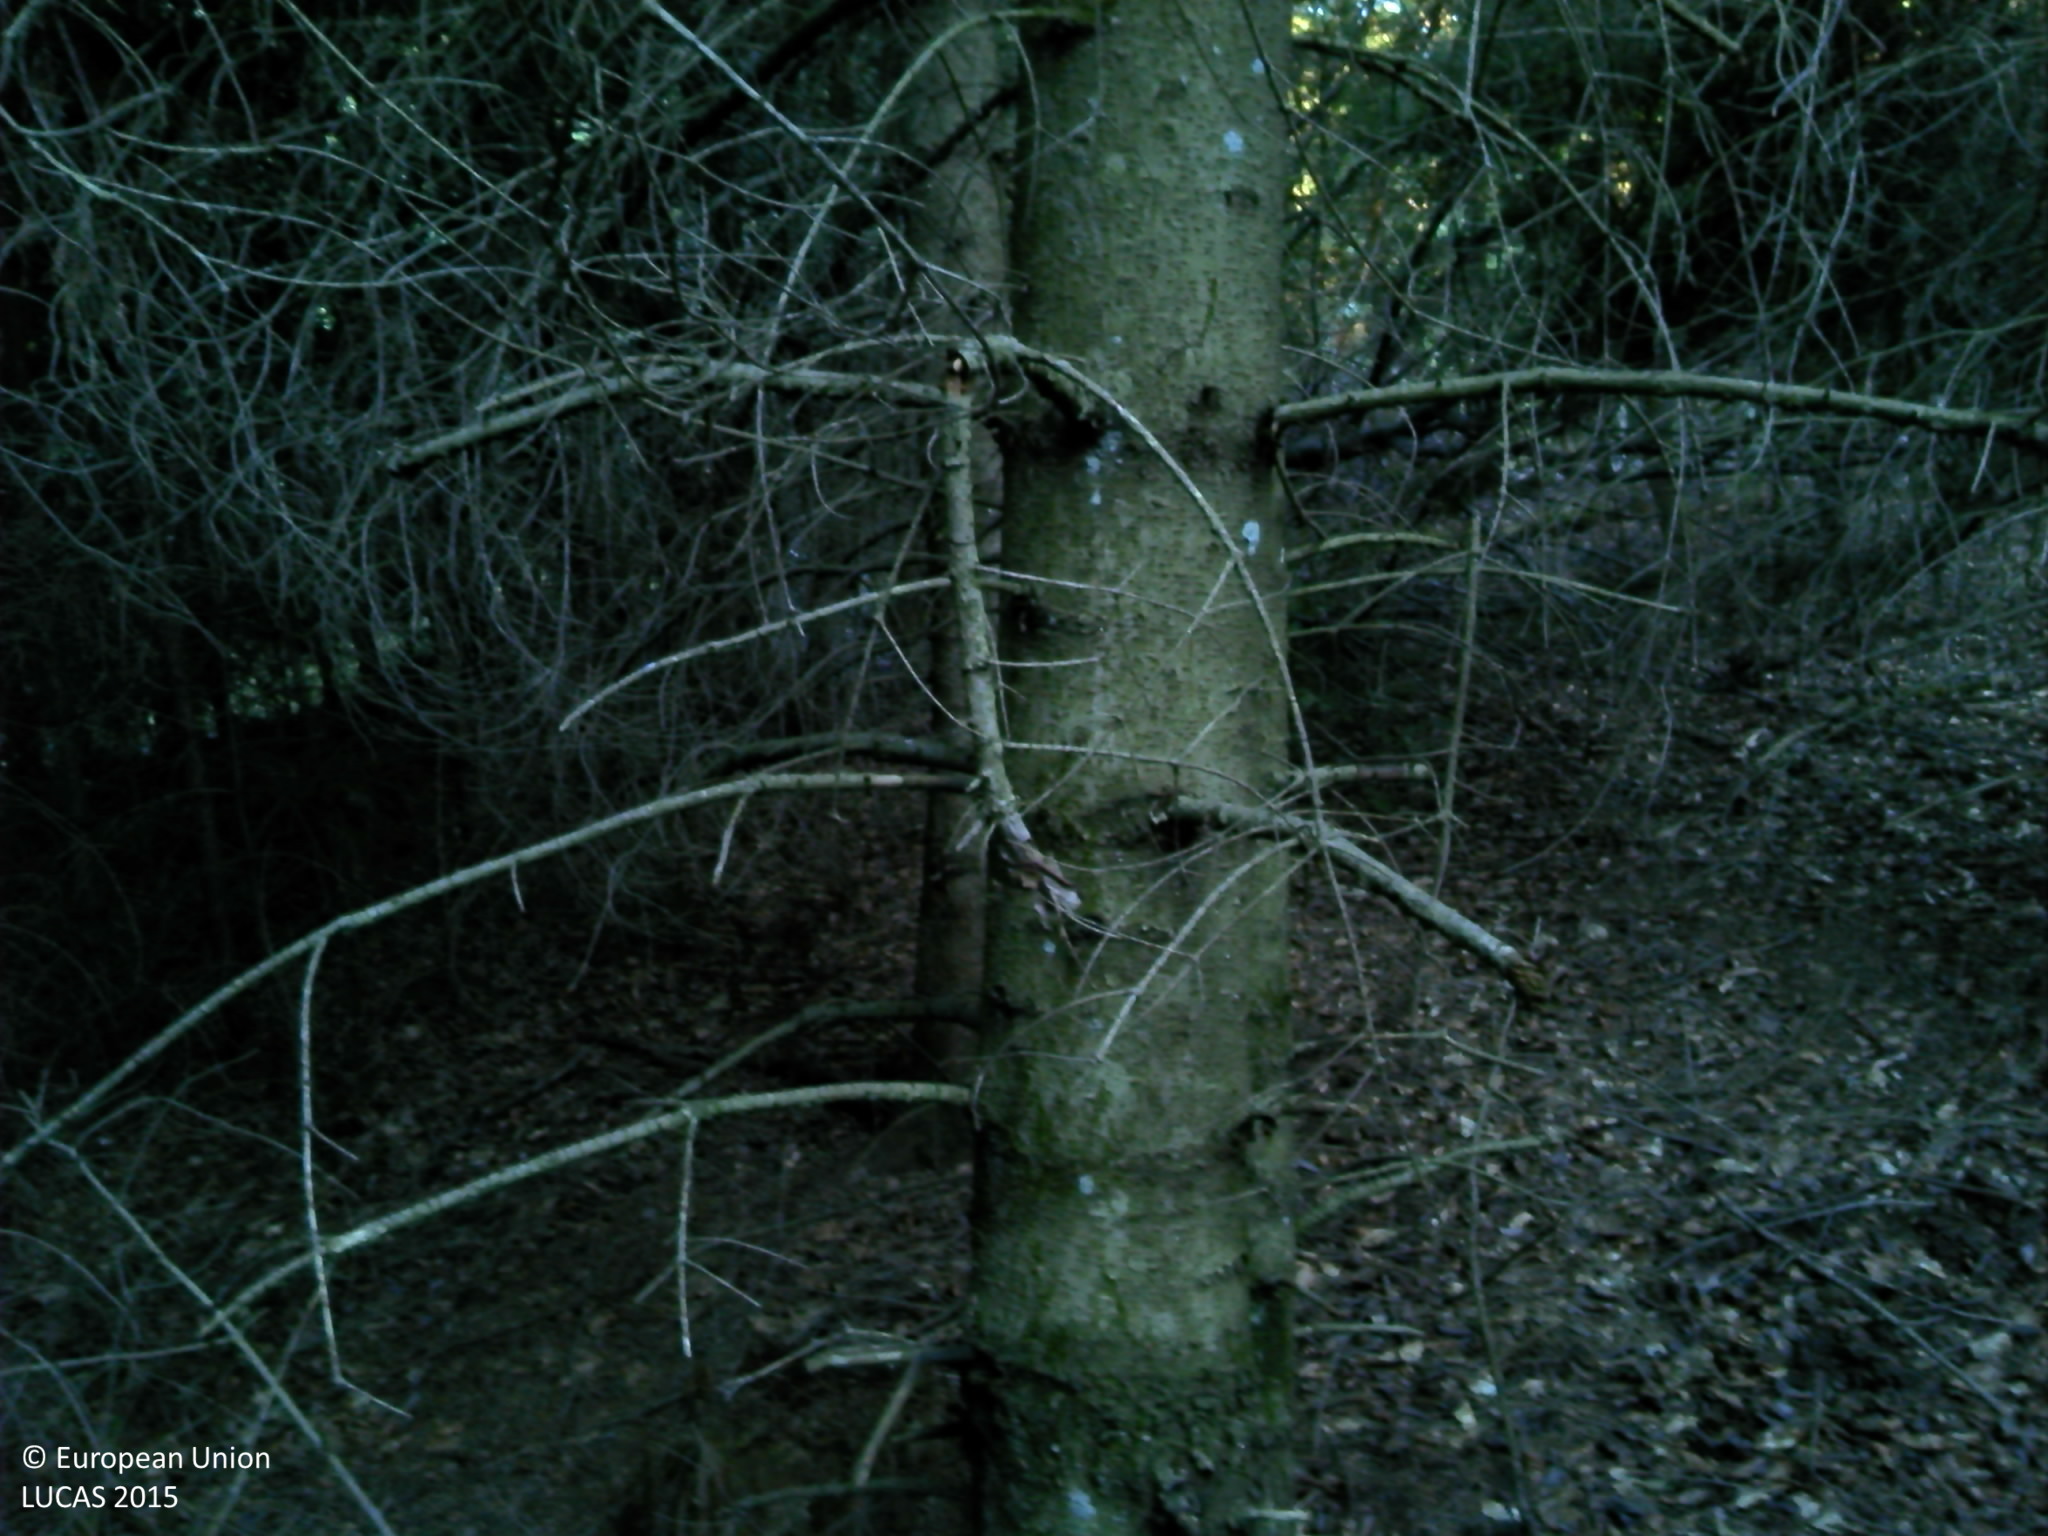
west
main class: Woodland
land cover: Spruce dominated mixed woodland
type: alpine coniferous forest
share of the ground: > 75 %
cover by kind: coniferous forest trees 60 %, broadleaved forest trees 35 %, unconsolidated bare surface 5 %
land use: Forestry
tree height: > 5 m
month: August
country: FR
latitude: 48.2869
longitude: 6.8606
